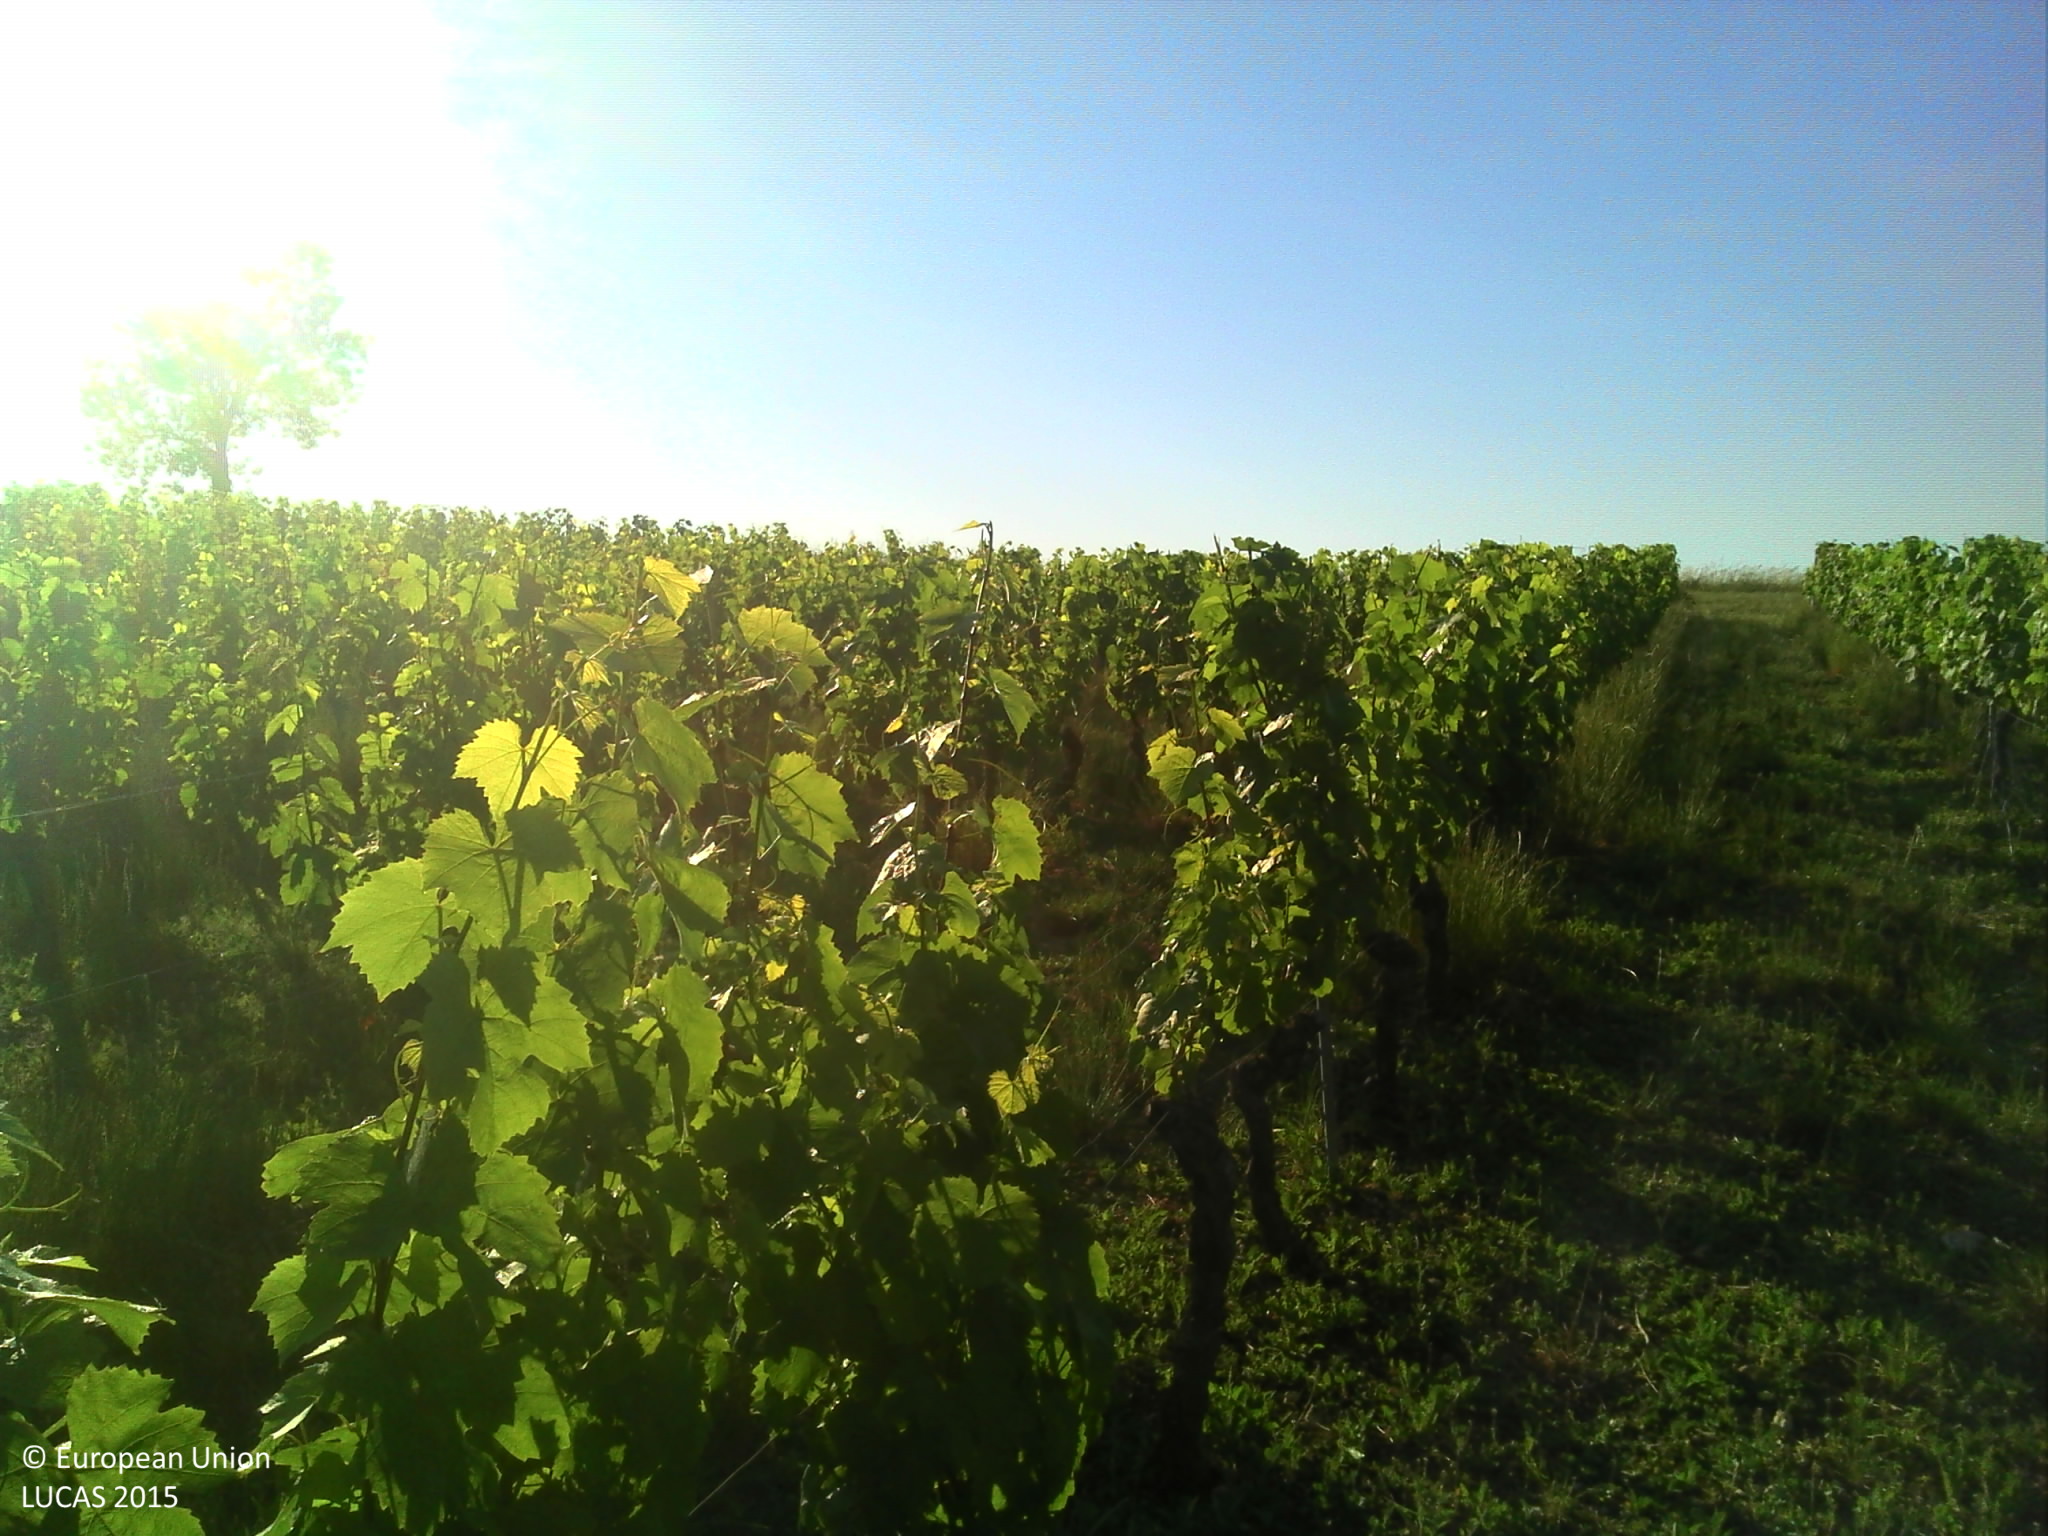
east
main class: Cropland
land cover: Vineyards
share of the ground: 10 - 25 %
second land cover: Spontaneously vegetated surfaces
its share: > 75 %
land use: Agriculture (excluding fallow land and kitchen gardens)
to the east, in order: Vineyards; Spontaneously vegetated surfaces; Grassland without tree/shrub cover; Grass margins; Paved roads, cycling and walking lanes; Grass margins; Ditches and canals; Vineyards; Grassland without tree/shrub cover; Broadleaved woodland
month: June
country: FR
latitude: 44.0179
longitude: 1.9315
